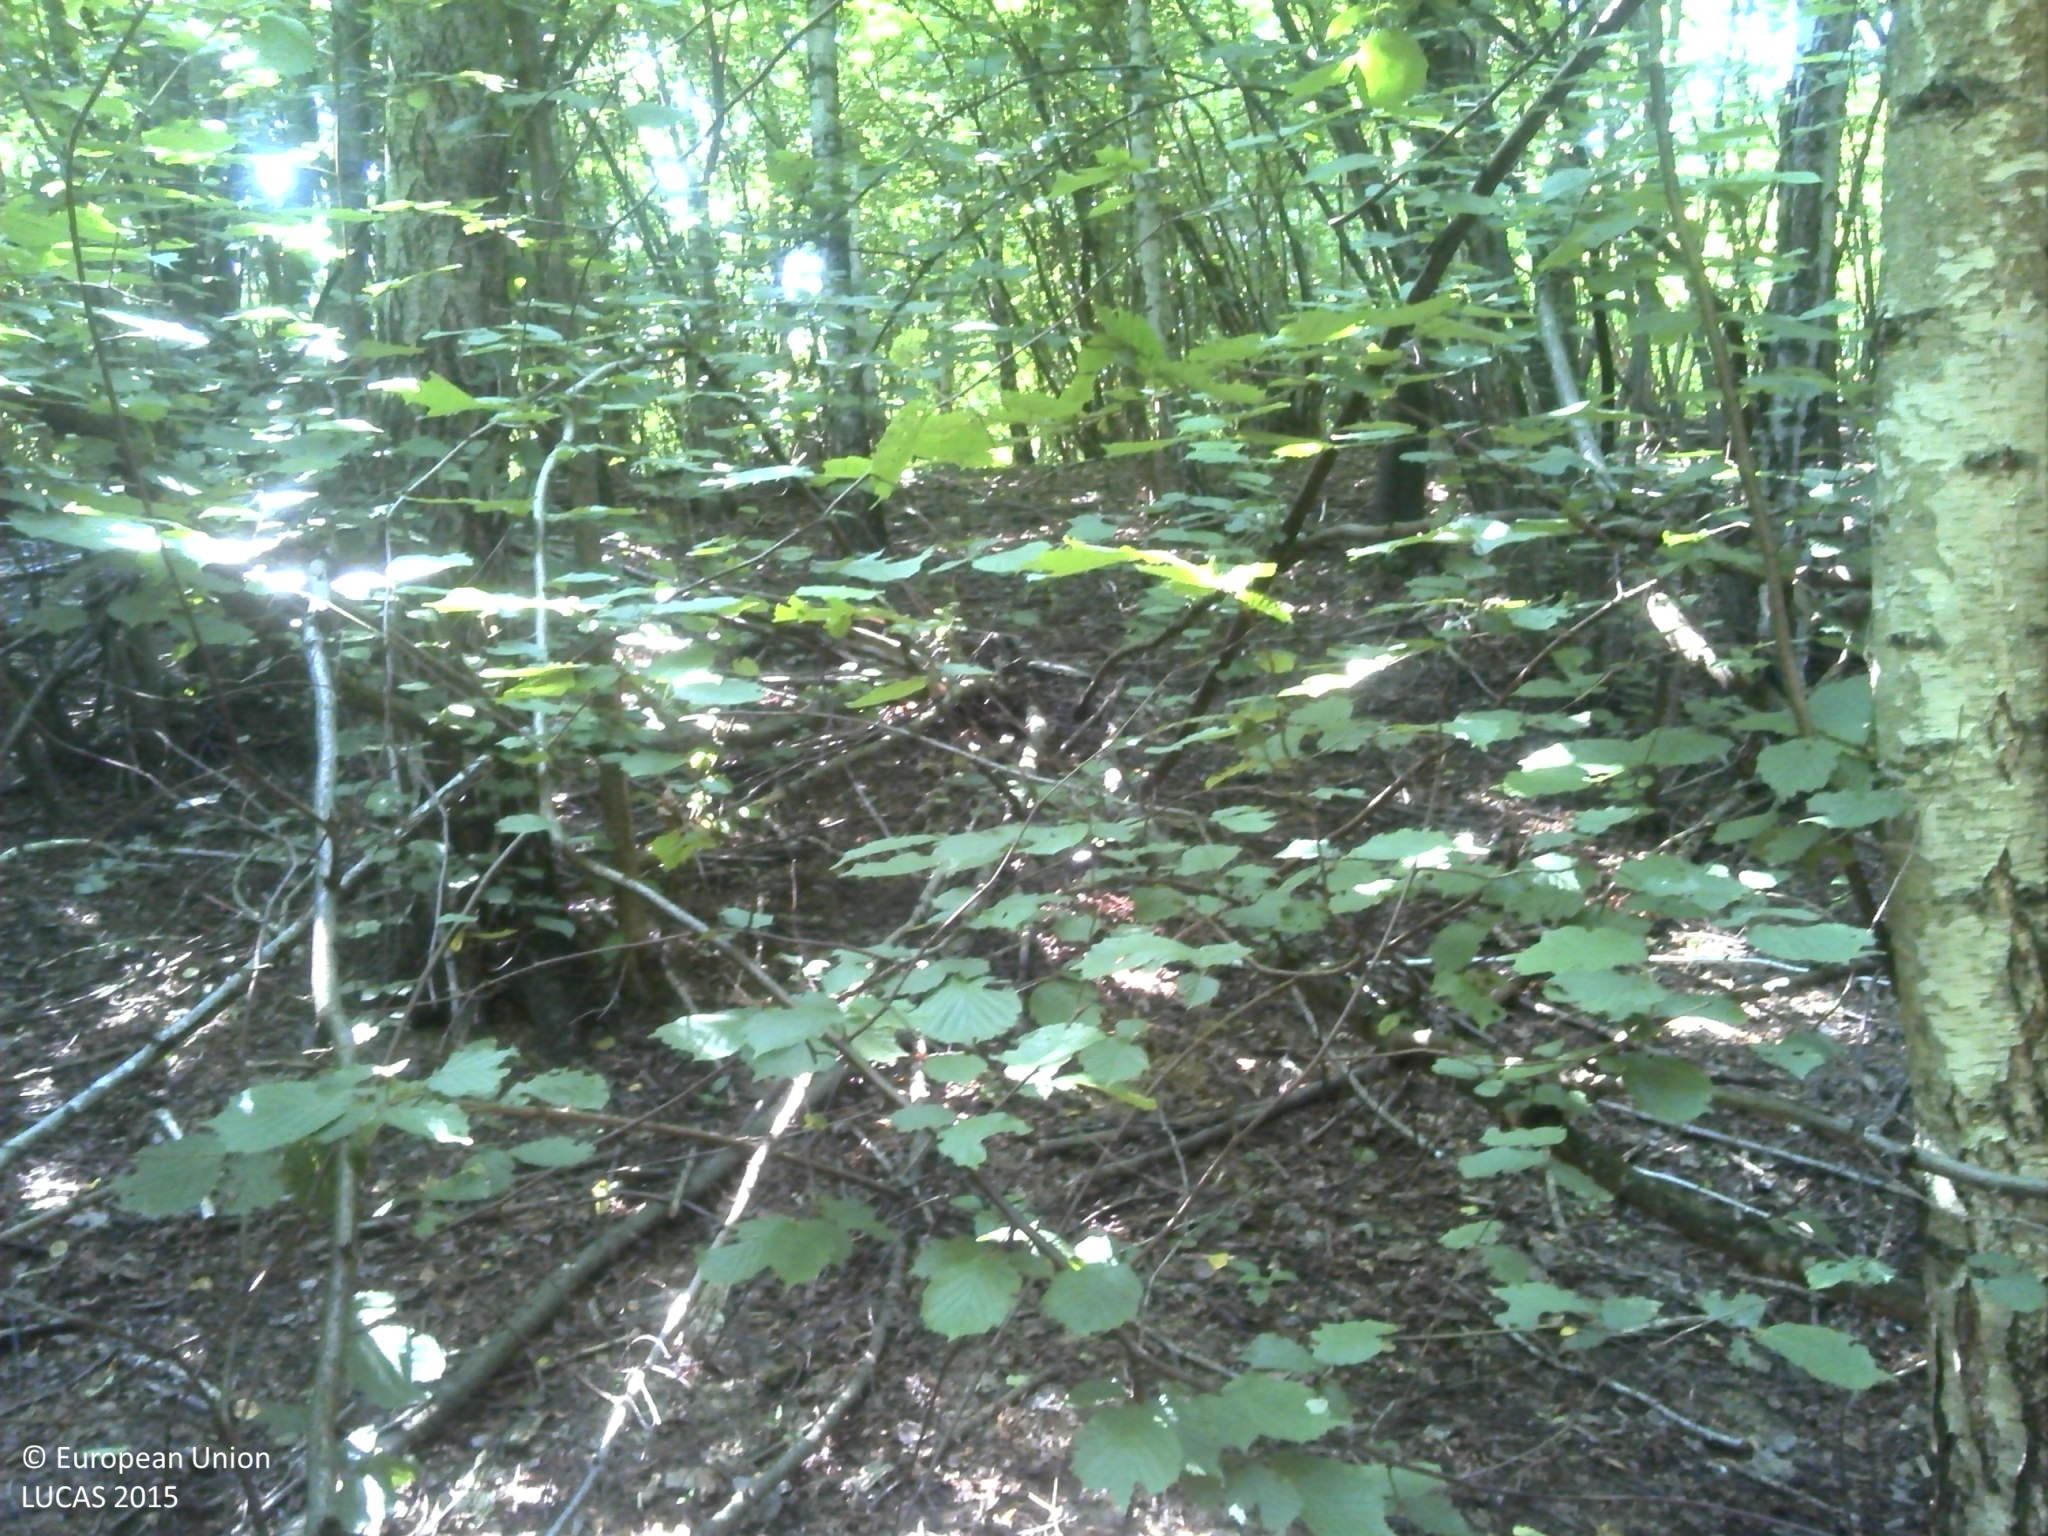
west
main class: Woodland
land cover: Broadleaved woodland
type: acidophilous oak and oak-birch forest
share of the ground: > 75 %
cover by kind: broadleaved forest trees 90 %, shrubs 5 %, herbaceous plants 5 %
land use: Forestry
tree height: > 5 m
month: June
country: HR
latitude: 45.5900
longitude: 17.6291
